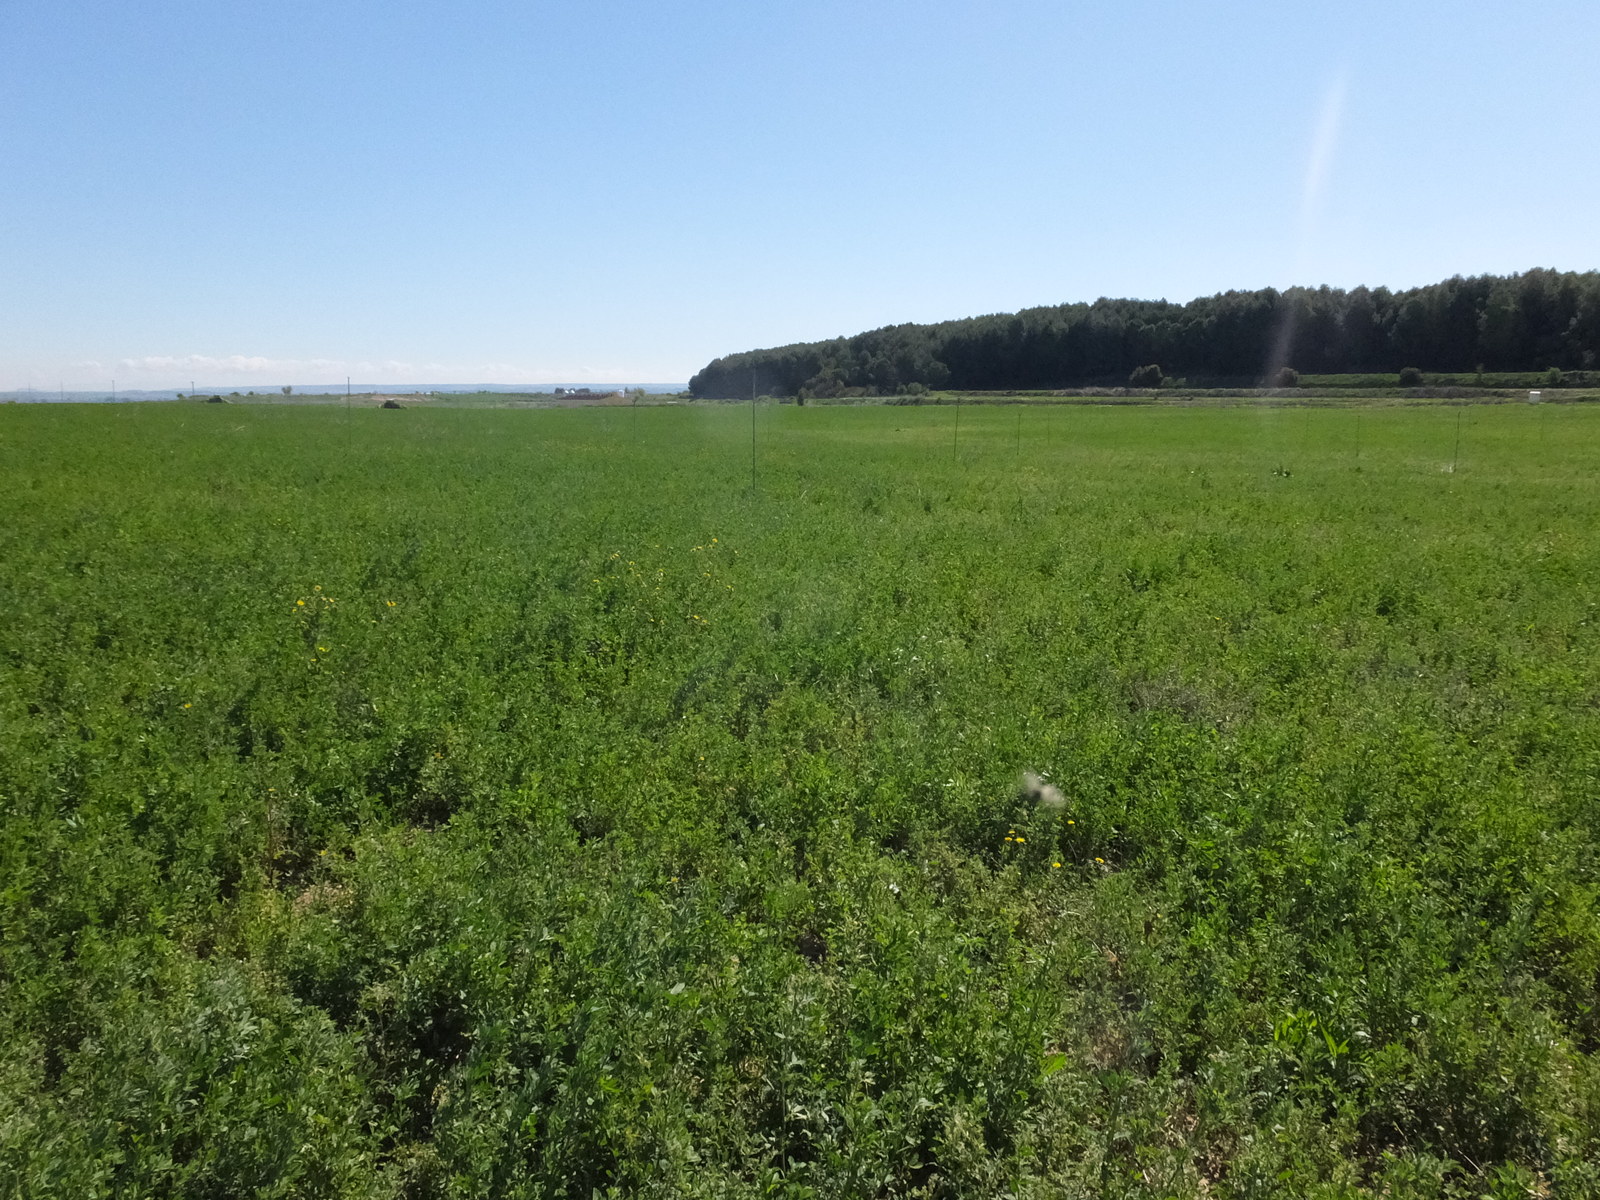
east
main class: Cropland
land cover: Lucerne
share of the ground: > 75 %
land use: Agriculture (excluding fallow land and kitchen gardens)
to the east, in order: Lucerne
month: April
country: ES
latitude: 41.8195
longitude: -0.2882
